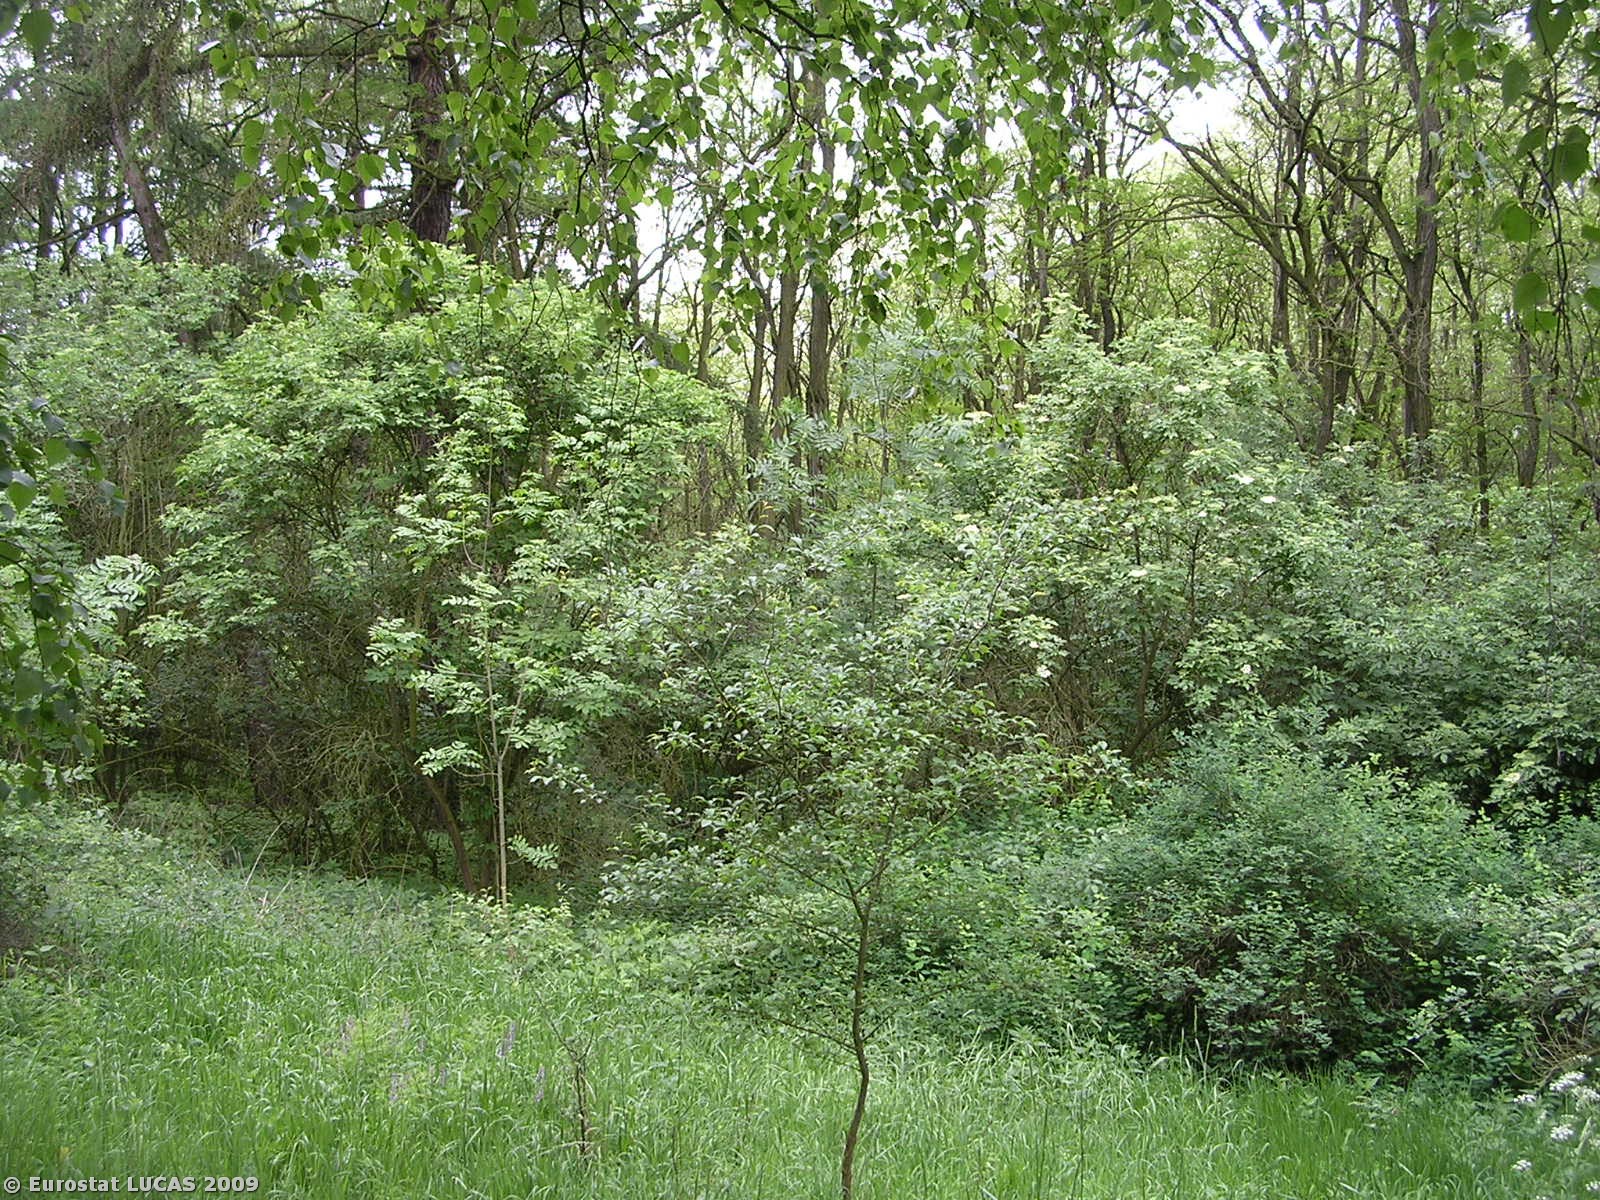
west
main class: Woodland
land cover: Broadleaved woodland
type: non-riverine alder, birch or aspen forest
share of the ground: 50 - 75 %
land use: Forestry
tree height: > 5 m
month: May
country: CZ
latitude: 50.1763
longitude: 14.2721
